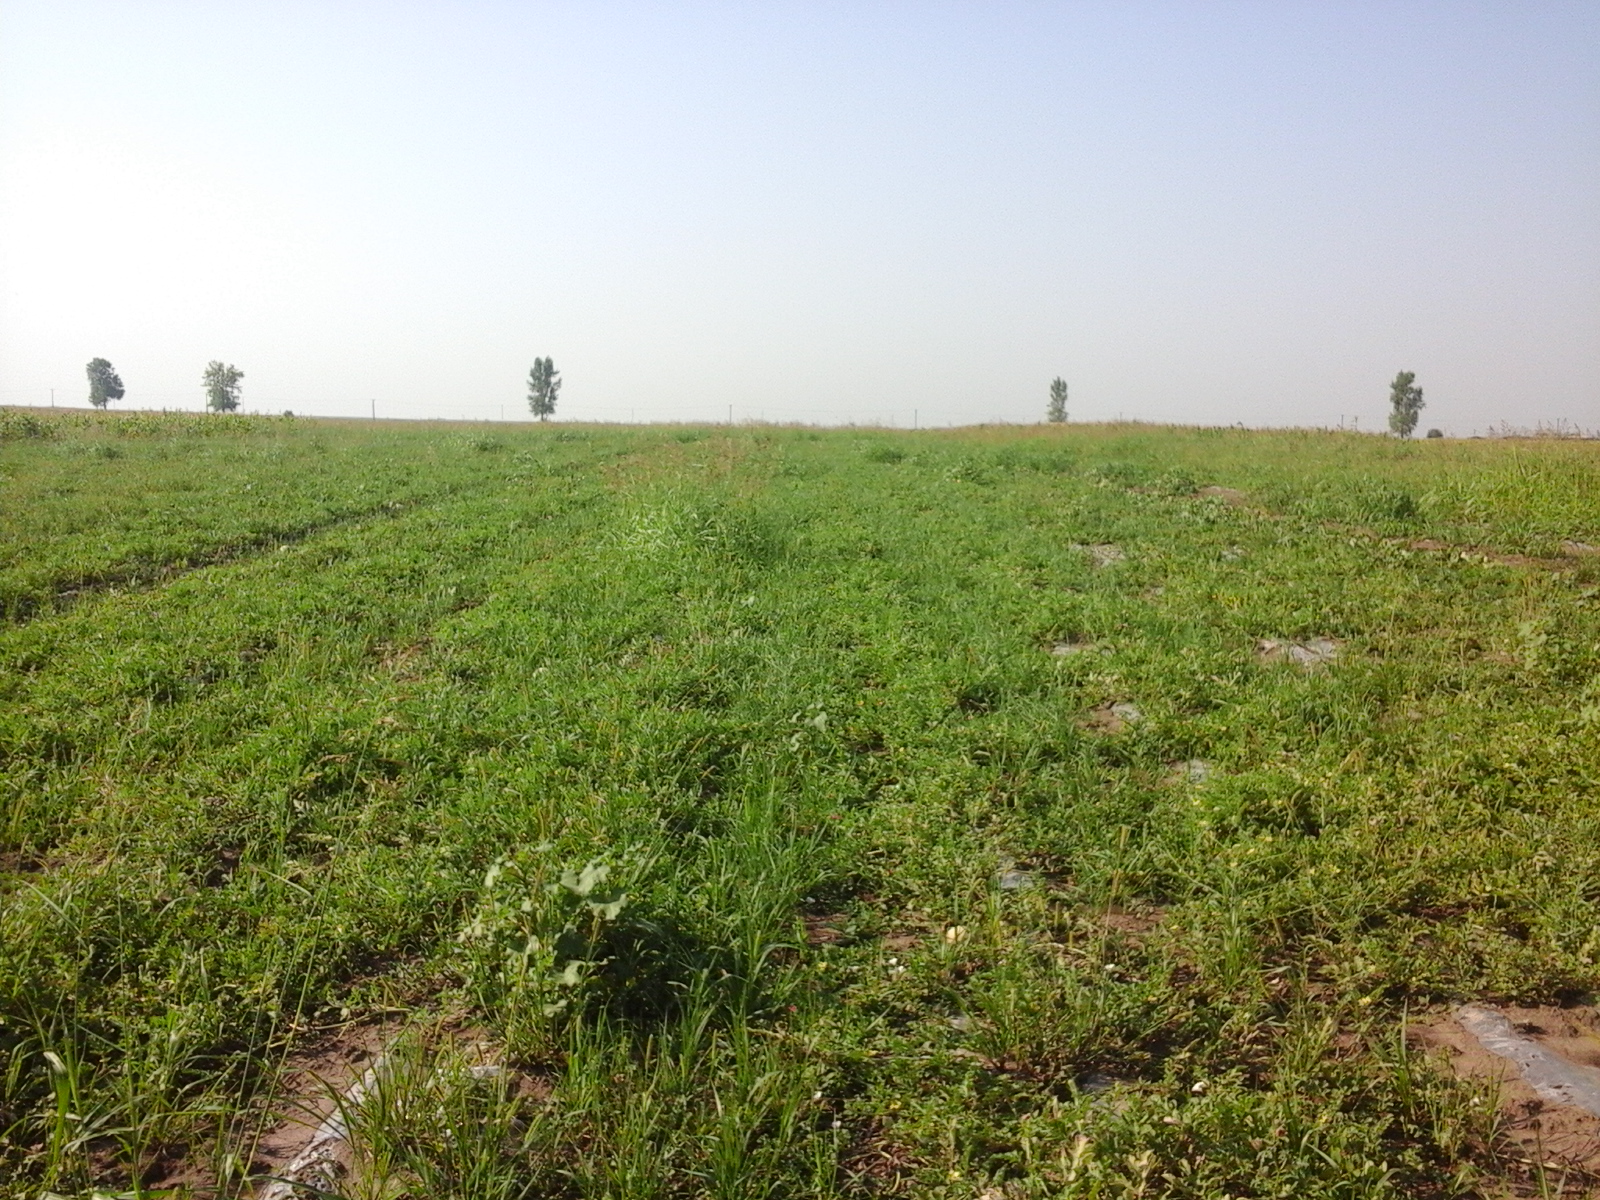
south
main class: Cropland
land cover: Other fresh vegetables
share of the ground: > 75 %
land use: Agriculture (excluding fallow land and kitchen gardens)
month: August
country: RO
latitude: 45.8382
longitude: 27.5790
